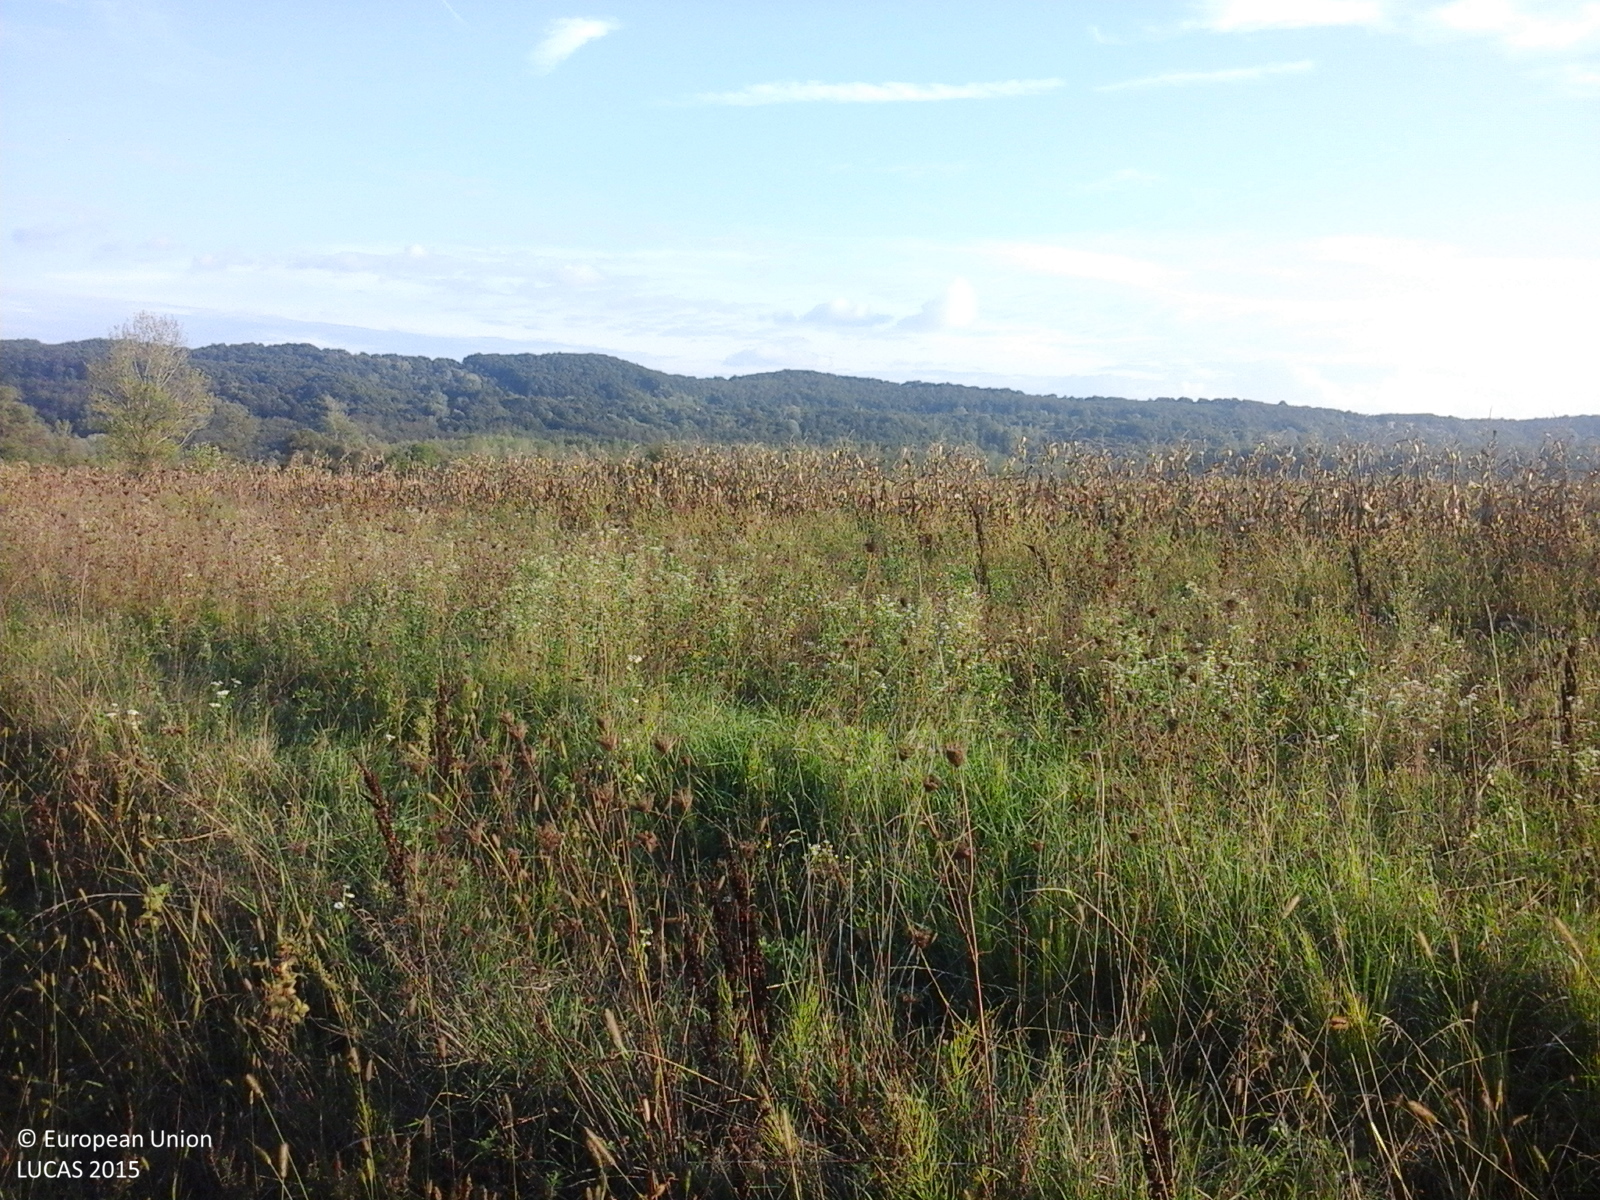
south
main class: Grassland
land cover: Spontaneously vegetated surfaces
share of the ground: > 75 %
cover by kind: herbaceous plants 100 %
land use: Fallow land
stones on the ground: < 10 %
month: September
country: RO
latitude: 45.0069
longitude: 23.5706
